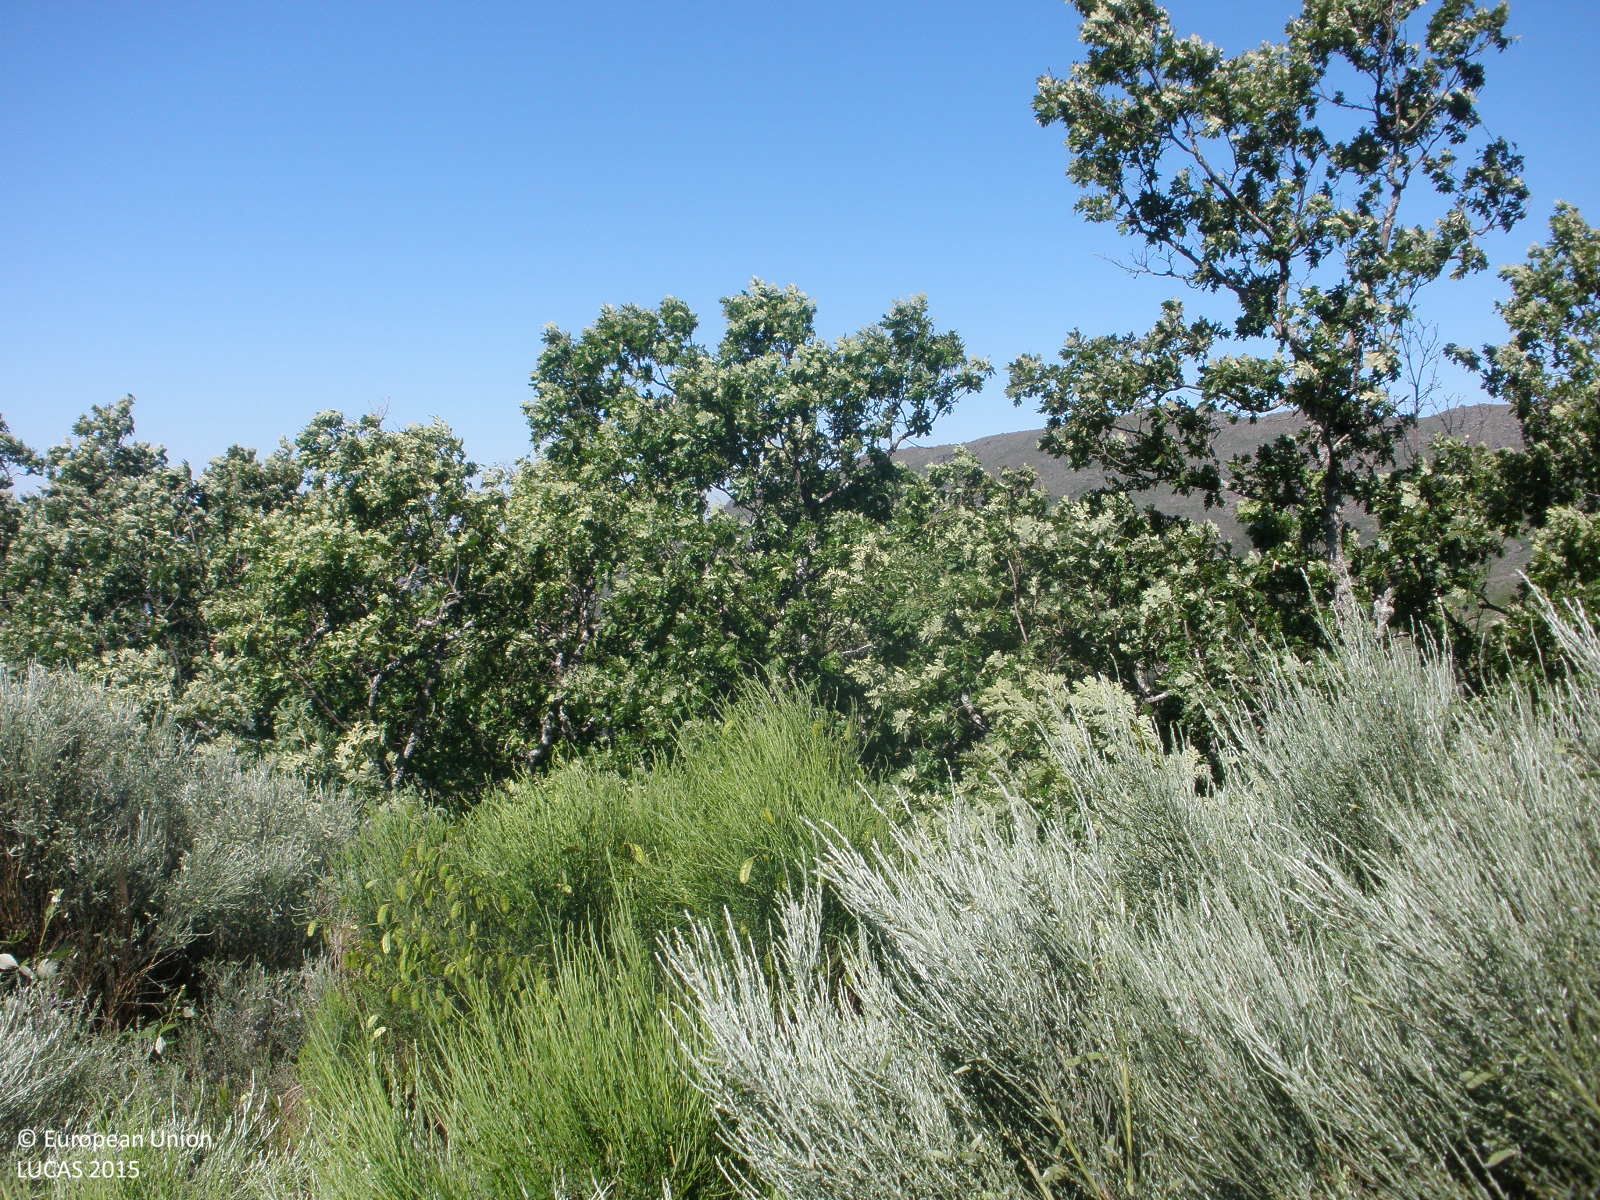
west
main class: Woodland
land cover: Broadleaved woodland
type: broadleaved evergreen forest
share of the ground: > 75 %
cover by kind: broadleaved forest trees 90 %, shrubs 10 %
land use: Forestry
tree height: < 5 m
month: May
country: ES
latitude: 40.2278
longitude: -6.7897
